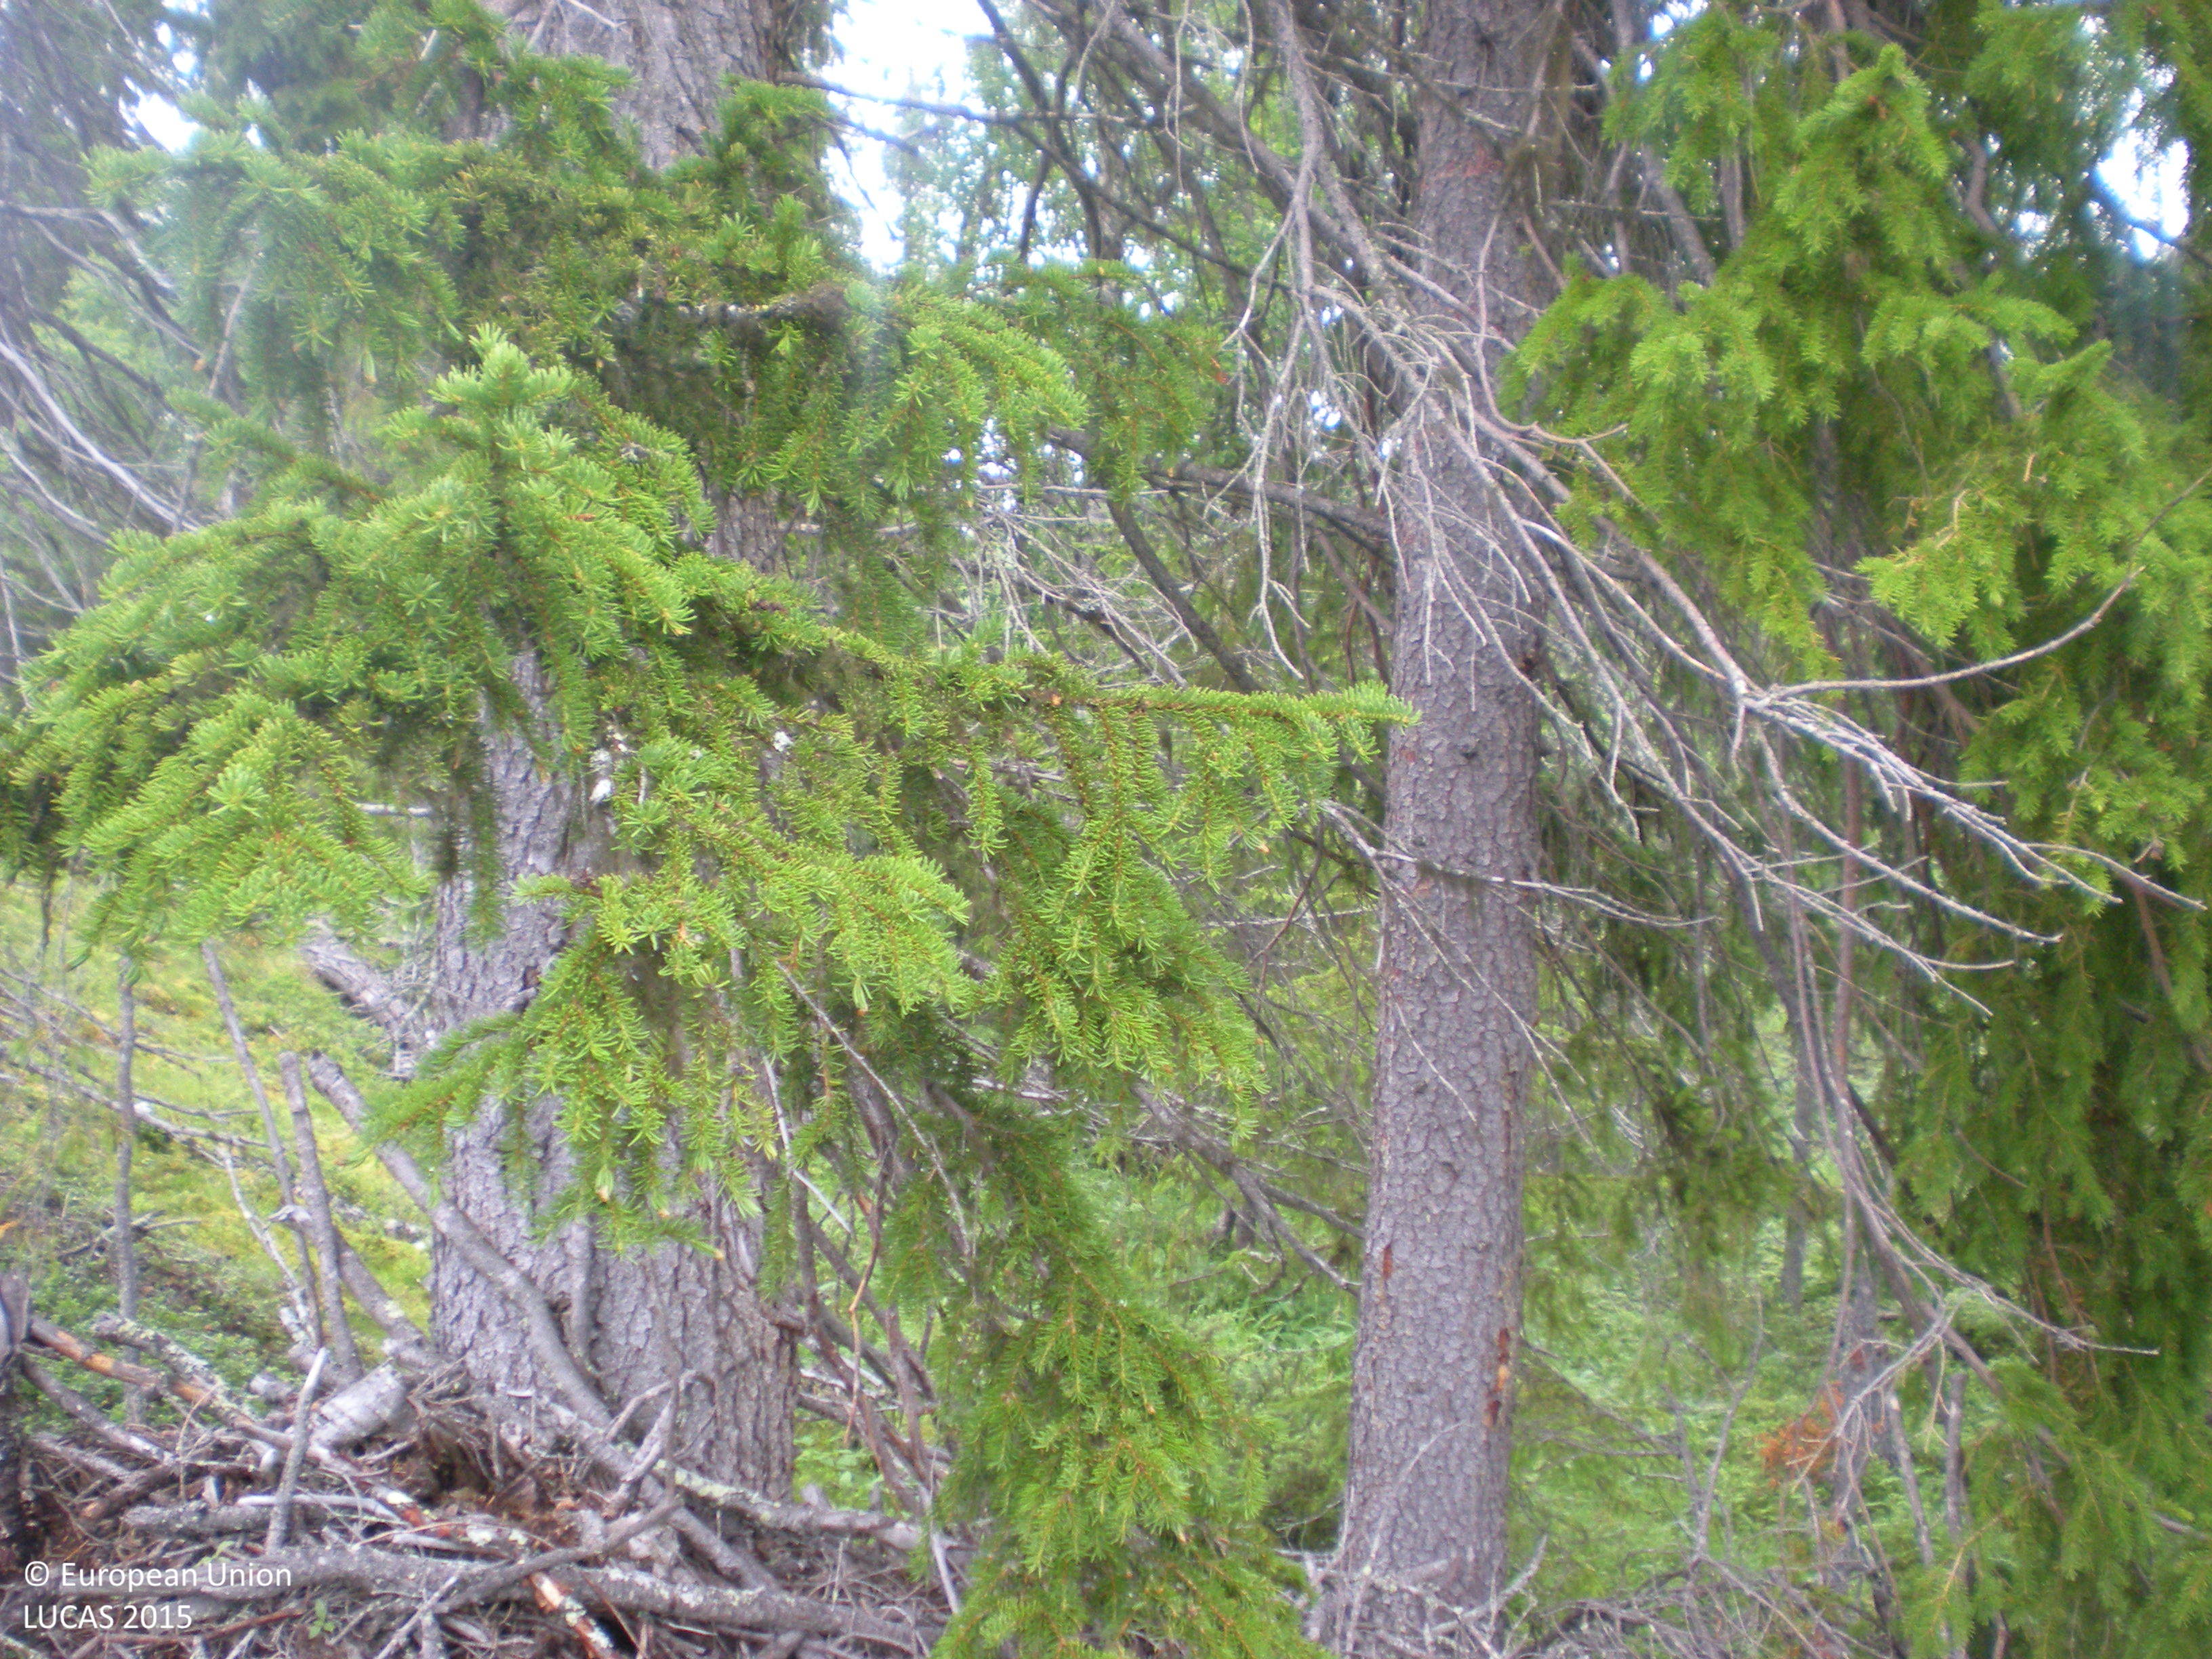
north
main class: Woodland
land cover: Spruce dominated mixed woodland
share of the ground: 50 - 75 %
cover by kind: coniferous forest trees 40 %, shrubs 25 %, broadleaved forest trees 20 %, lichens and mosses 10 %, herbaceous plants 5 %
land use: Forestry
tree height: > 5 m
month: August
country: SE
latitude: 66.0910
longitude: 18.2910
